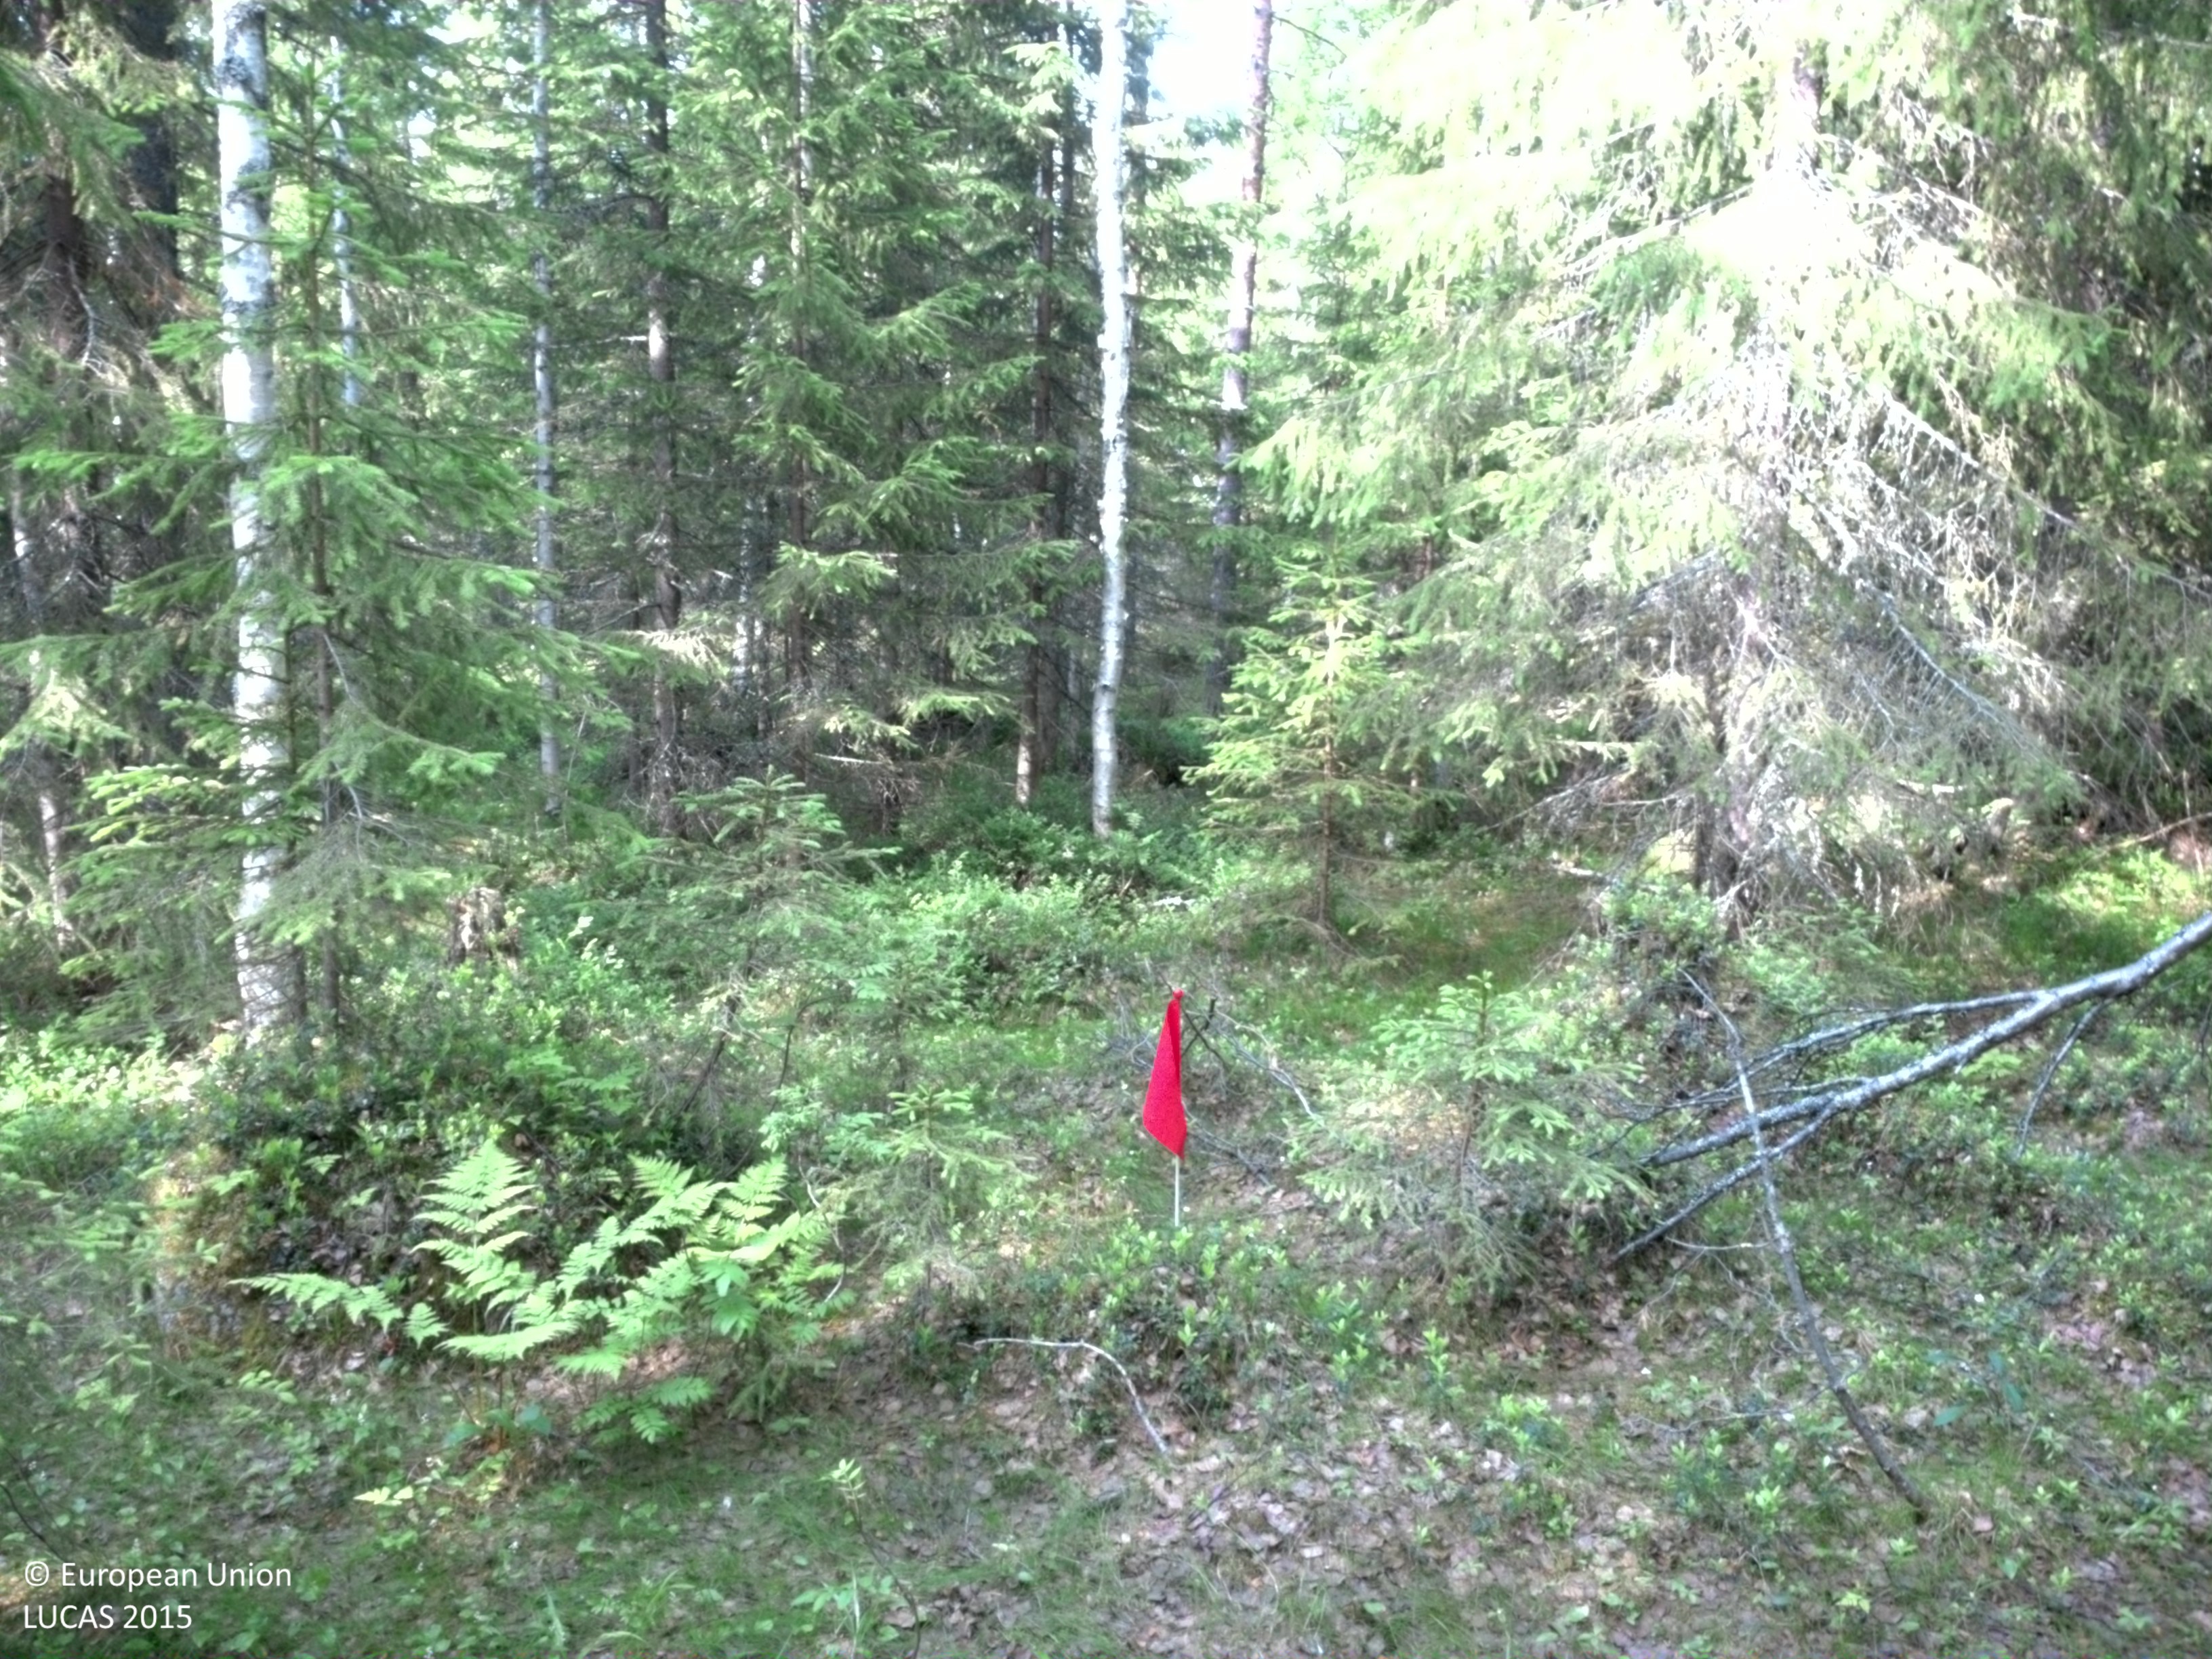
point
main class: Woodland
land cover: Other mixed woodland
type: boreal forest
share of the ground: 50 - 75 %
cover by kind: coniferous forest trees 45 %, shrubs 35 %, broadleaved forest trees 15 %, herbaceous plants 5 %
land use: Forestry
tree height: > 5 m
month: July
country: SE
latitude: 64.4456
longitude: 20.8467
